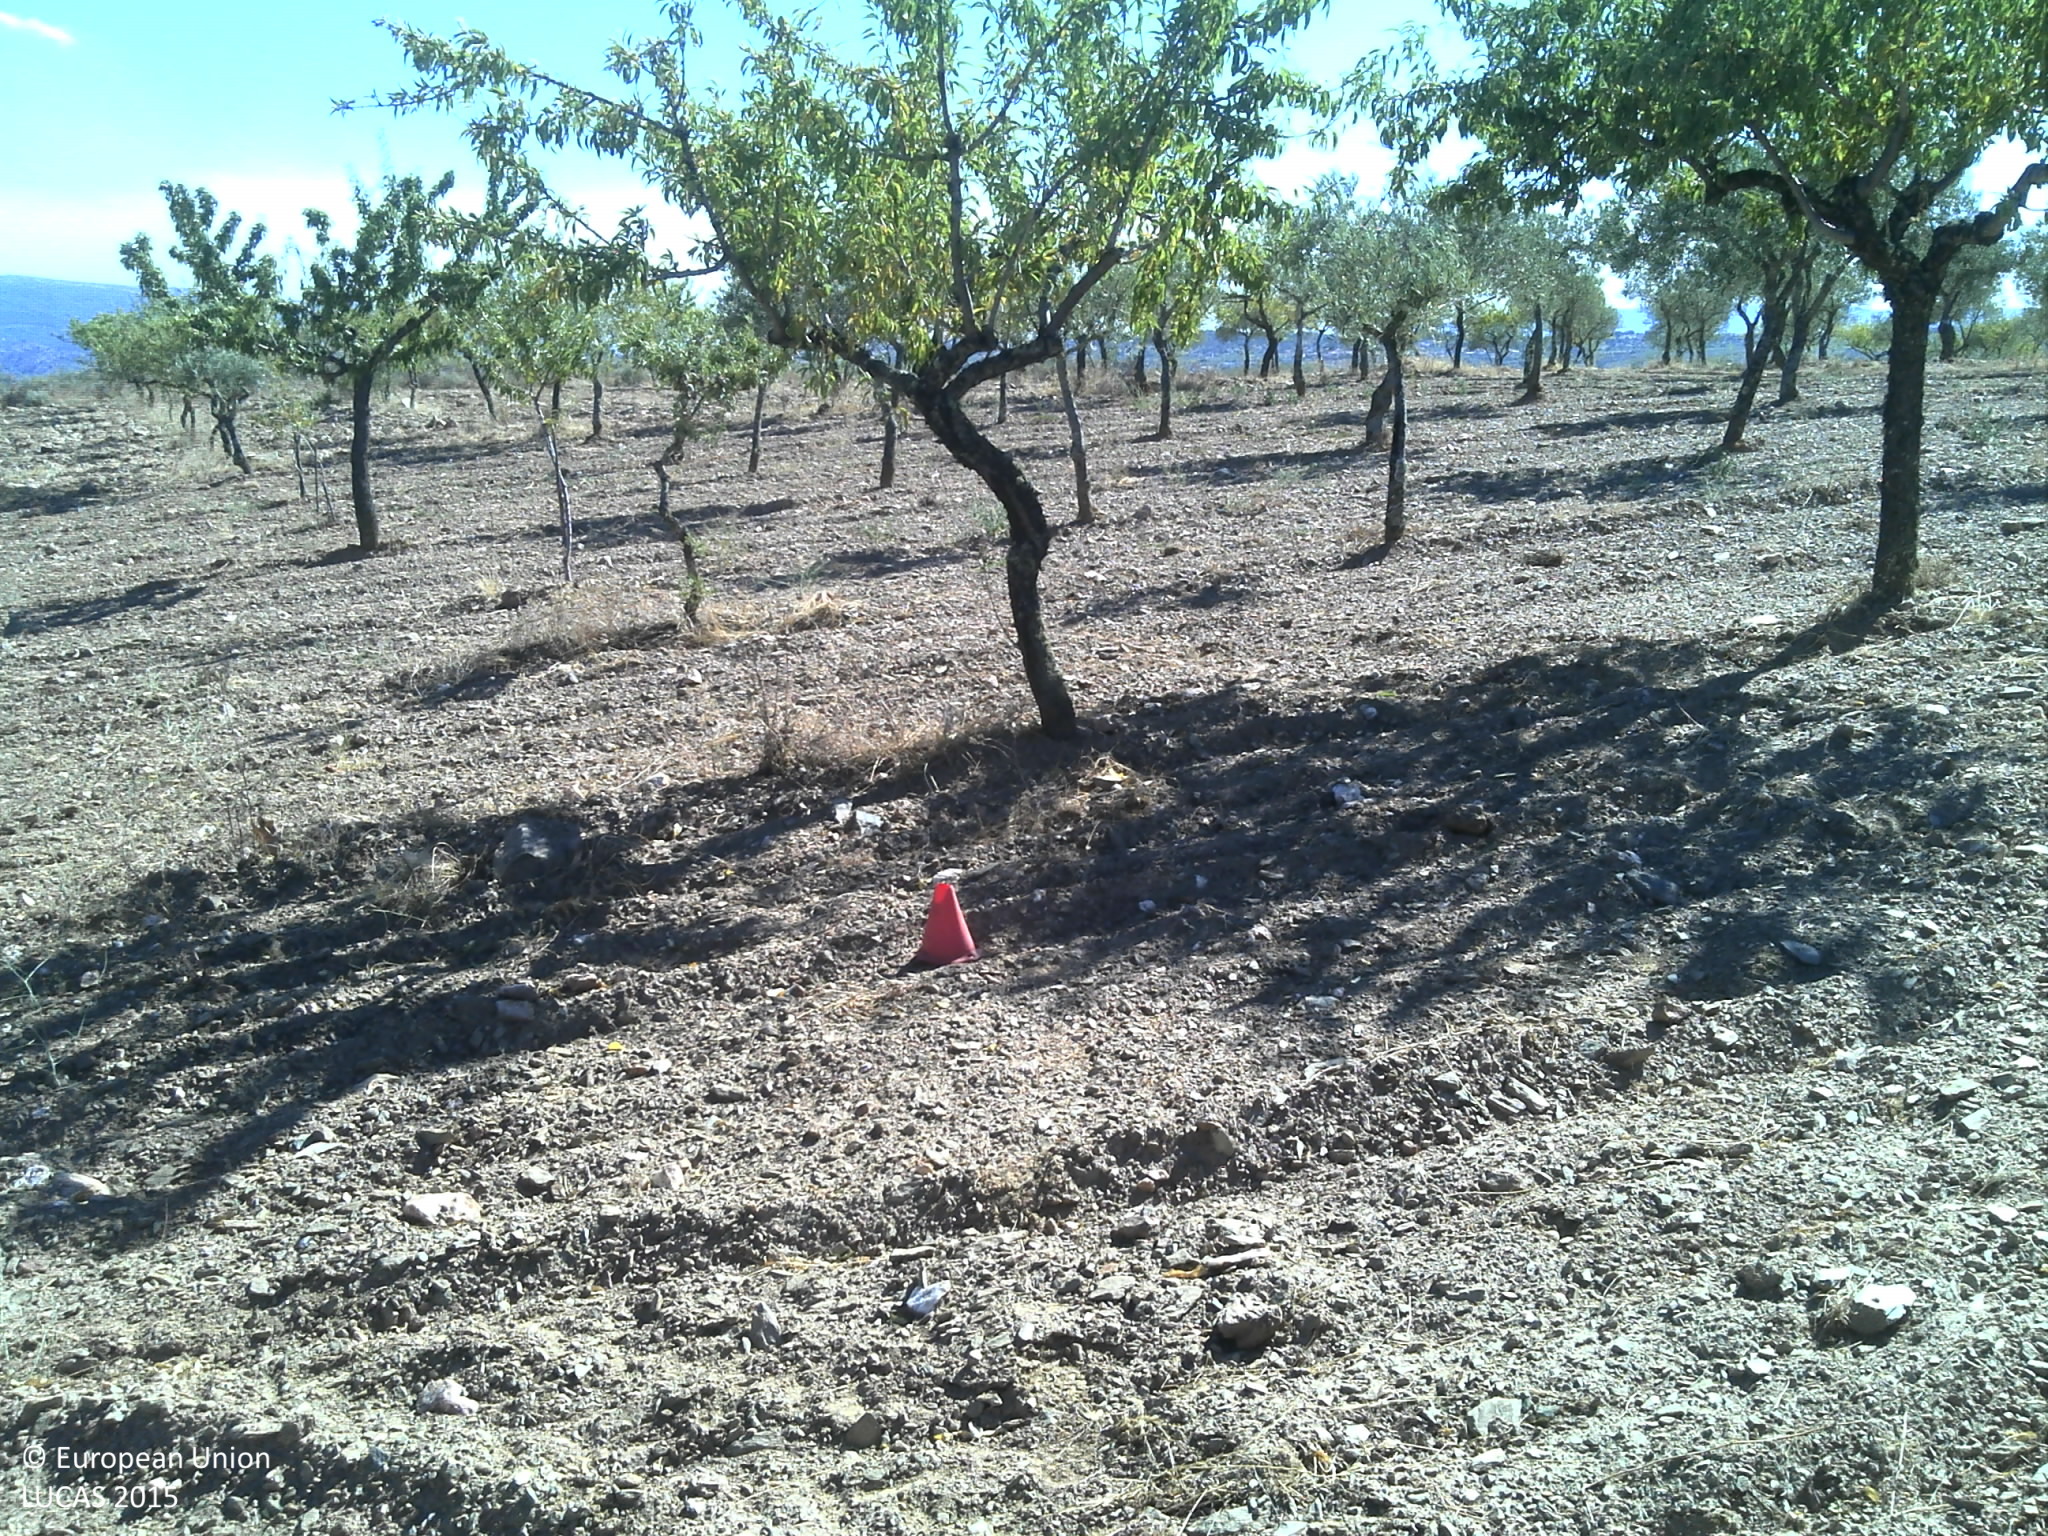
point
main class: Cropland
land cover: Nuts trees
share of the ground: < 10 %
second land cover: Other bare soil
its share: > 75 %
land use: Agriculture (excluding fallow land and kitchen gardens)
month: July
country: PT
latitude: 41.2774
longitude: -7.0045
